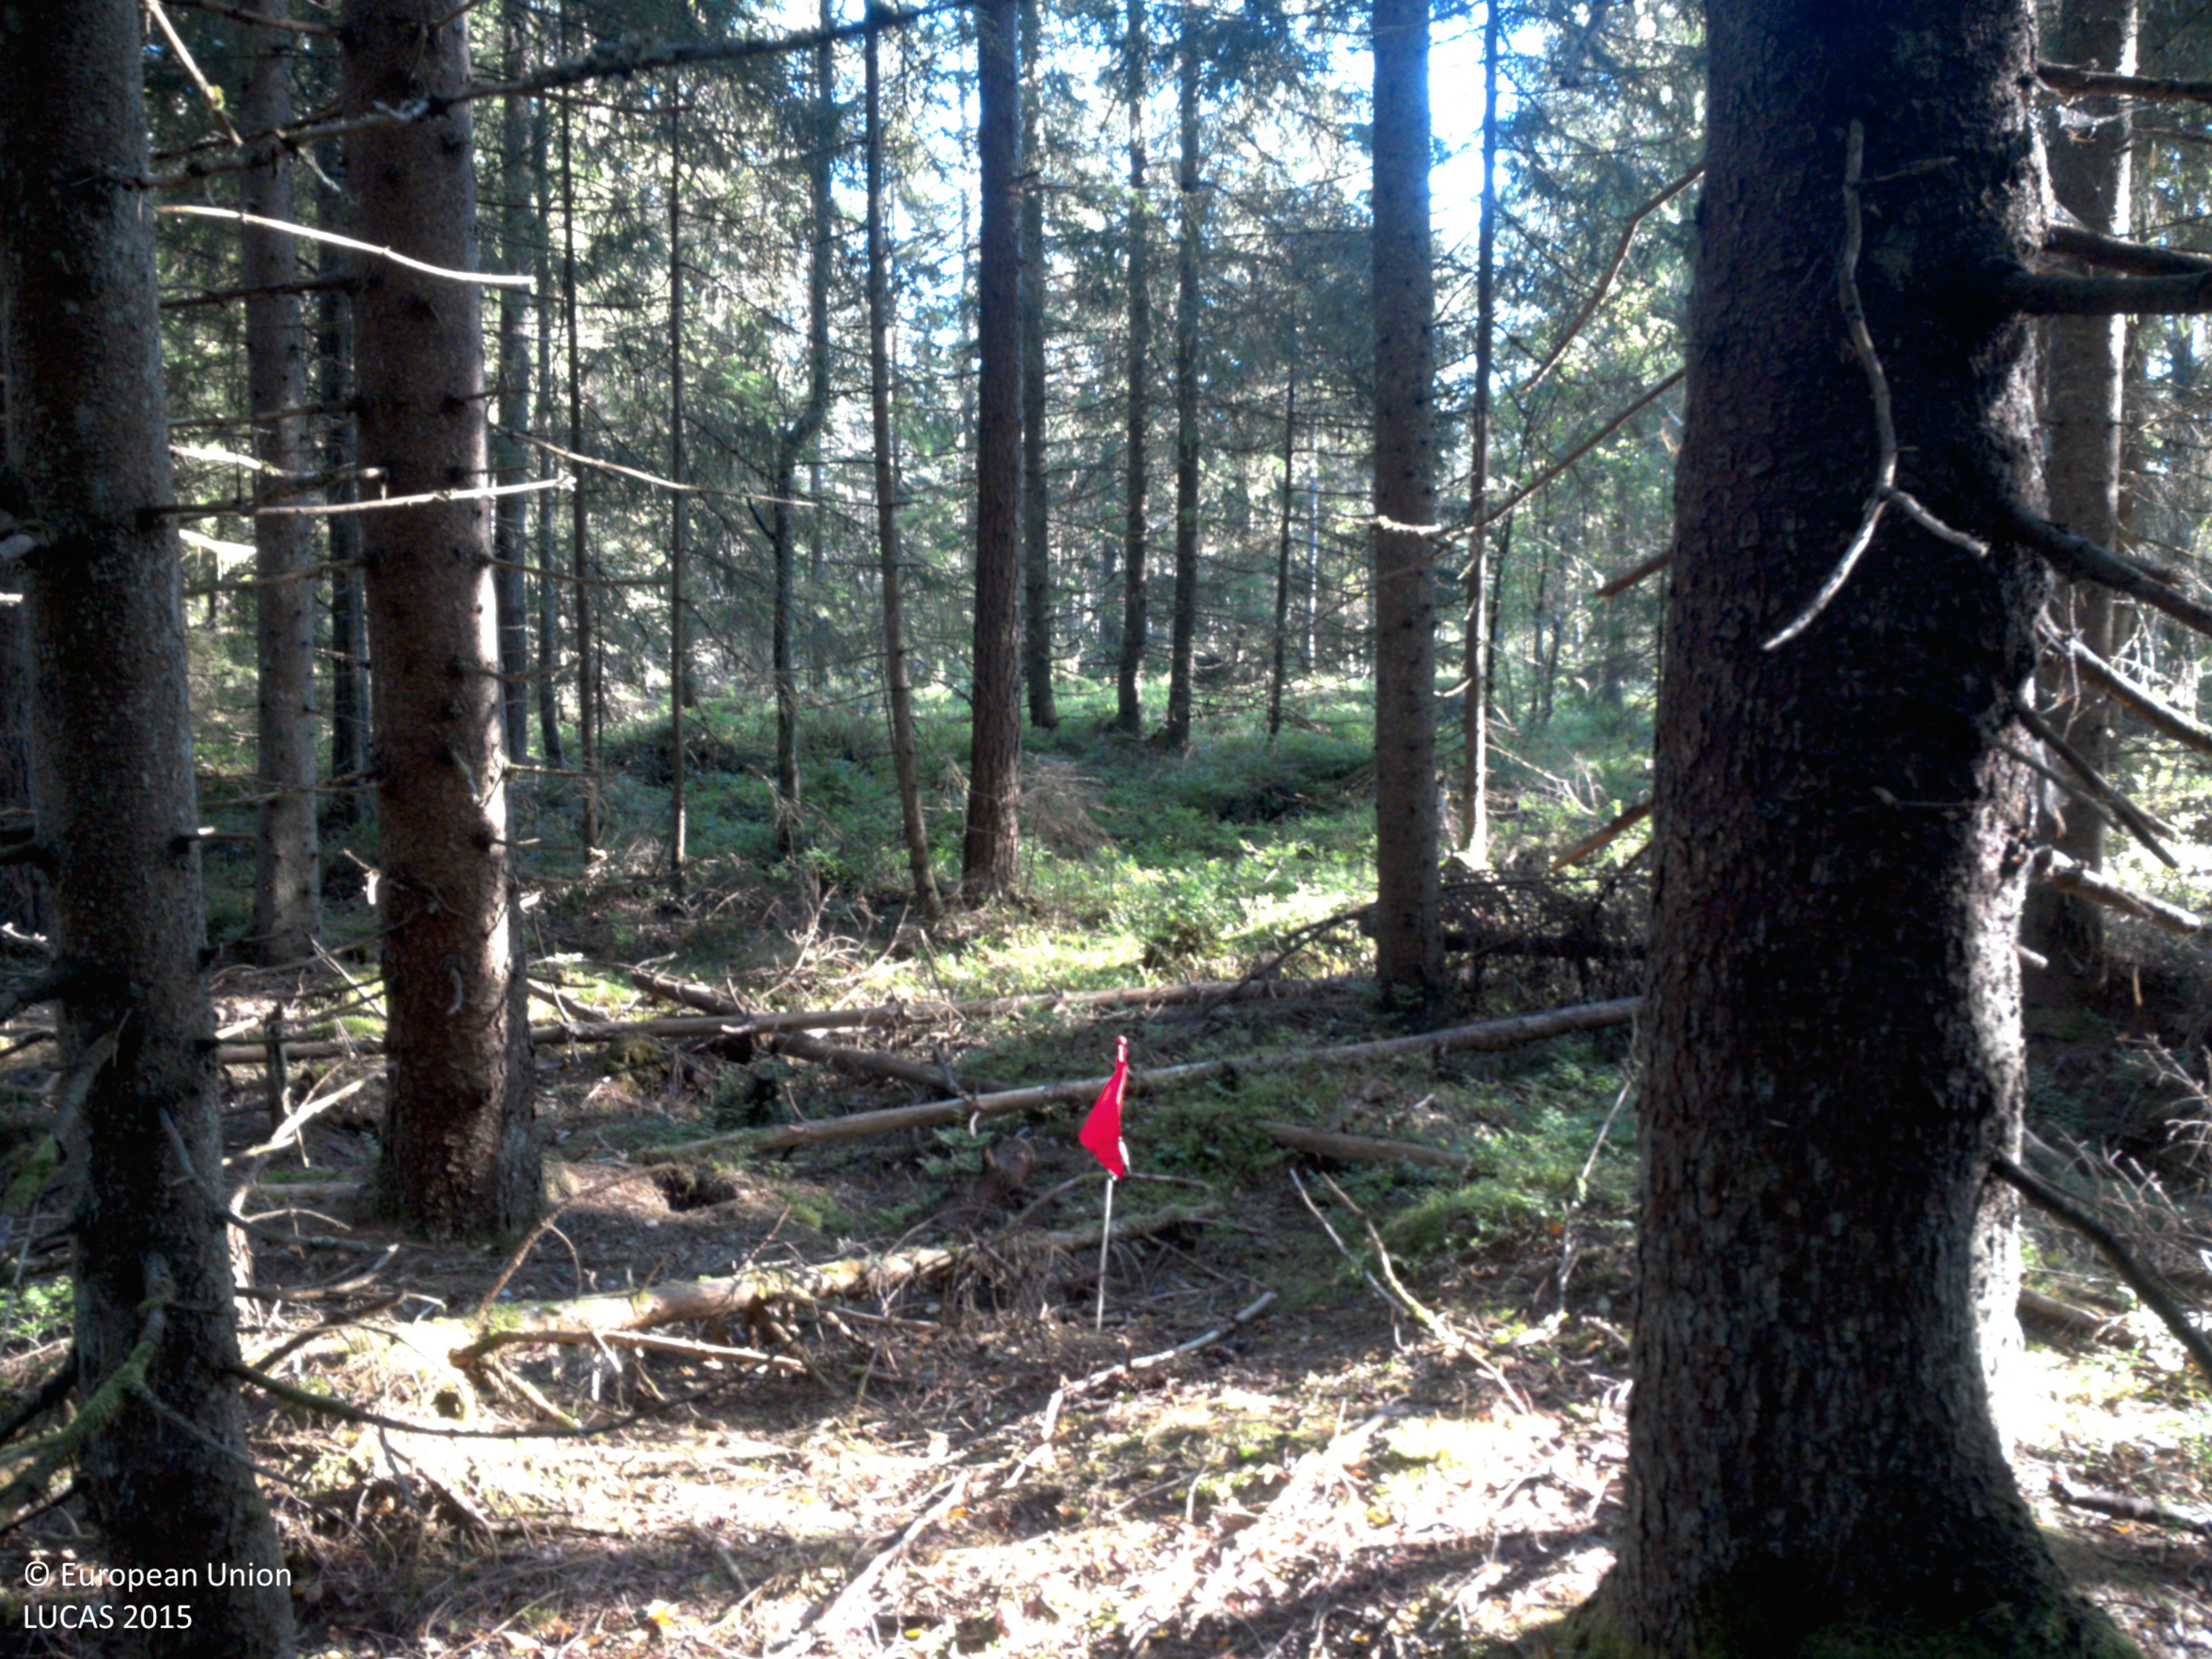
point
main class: Woodland
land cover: Spruce dominated coniferous woodland
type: boreal forest
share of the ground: 50 - 75 %
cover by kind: coniferous forest trees 60 %, shrubs 15 %, lichens and mosses 15 %, herbaceous plants 10 %
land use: Forestry
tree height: > 5 m
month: August
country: SE
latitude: 58.5426
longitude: 12.2460
